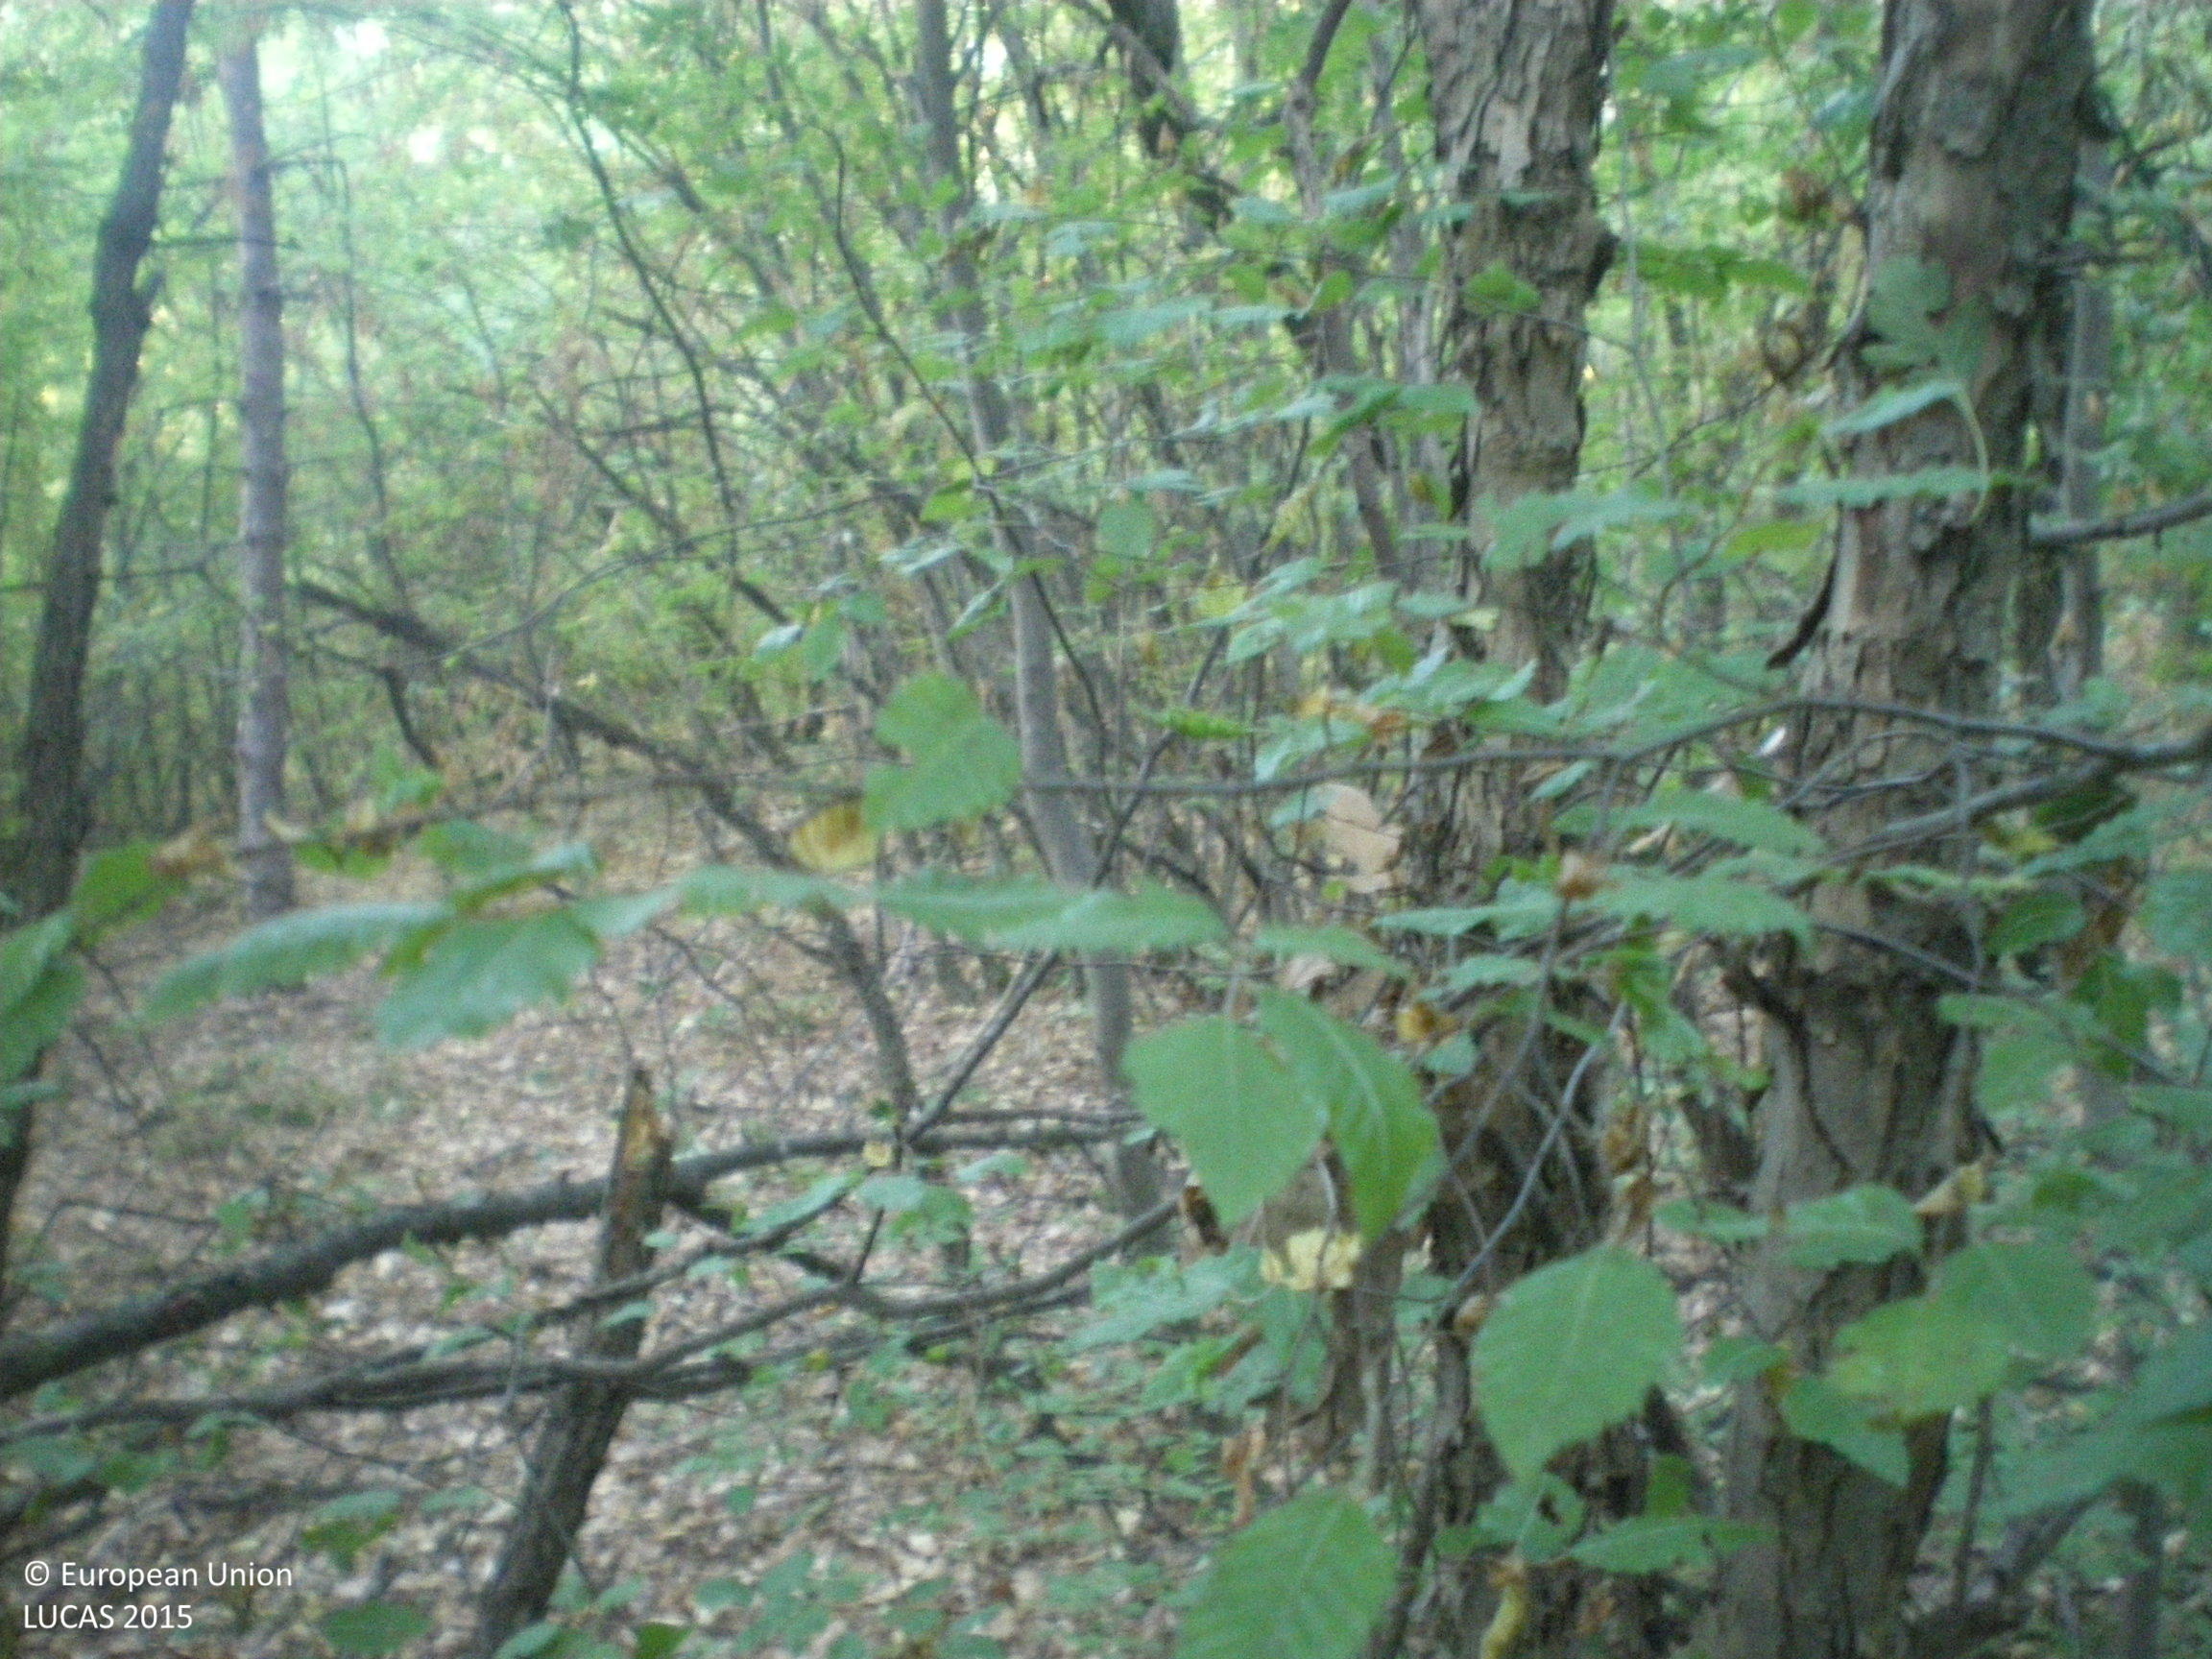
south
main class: Woodland
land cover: Broadleaved woodland
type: mesophytic deciduous forest
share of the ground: > 75 %
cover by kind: broadleaved forest trees 95 %, unconsolidated bare surface 5 %
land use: Forestry
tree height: > 5 m
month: August
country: BG
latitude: 42.4616
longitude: 25.5021
